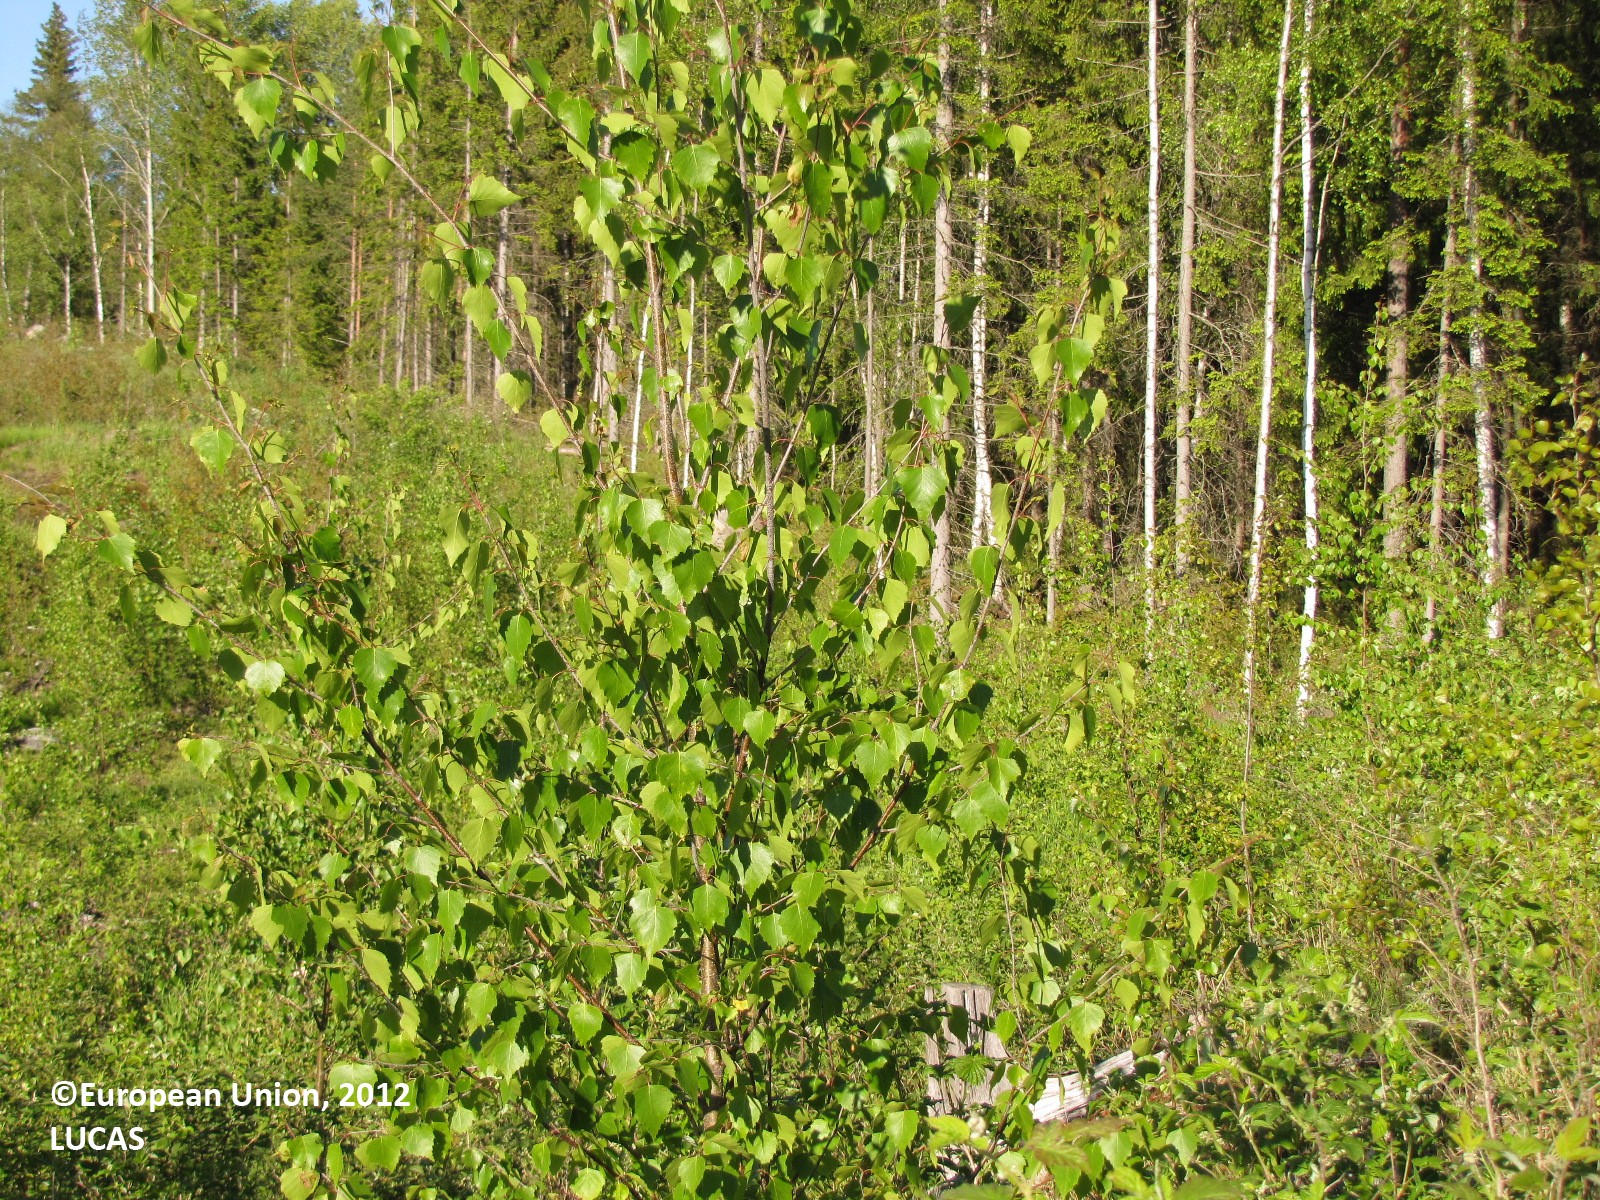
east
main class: Woodland
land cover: Broadleaved woodland
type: boreal forest
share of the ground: 25 - 50 %
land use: Forestry
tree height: < 5 m
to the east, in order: Broadleaved woodland; Ditches and canals; Spruce dominated coniferous woodland; Pine dominated coniferous woodland; Spruce dominated coniferous woodland
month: June
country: FI
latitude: 61.3926
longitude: 22.9330
